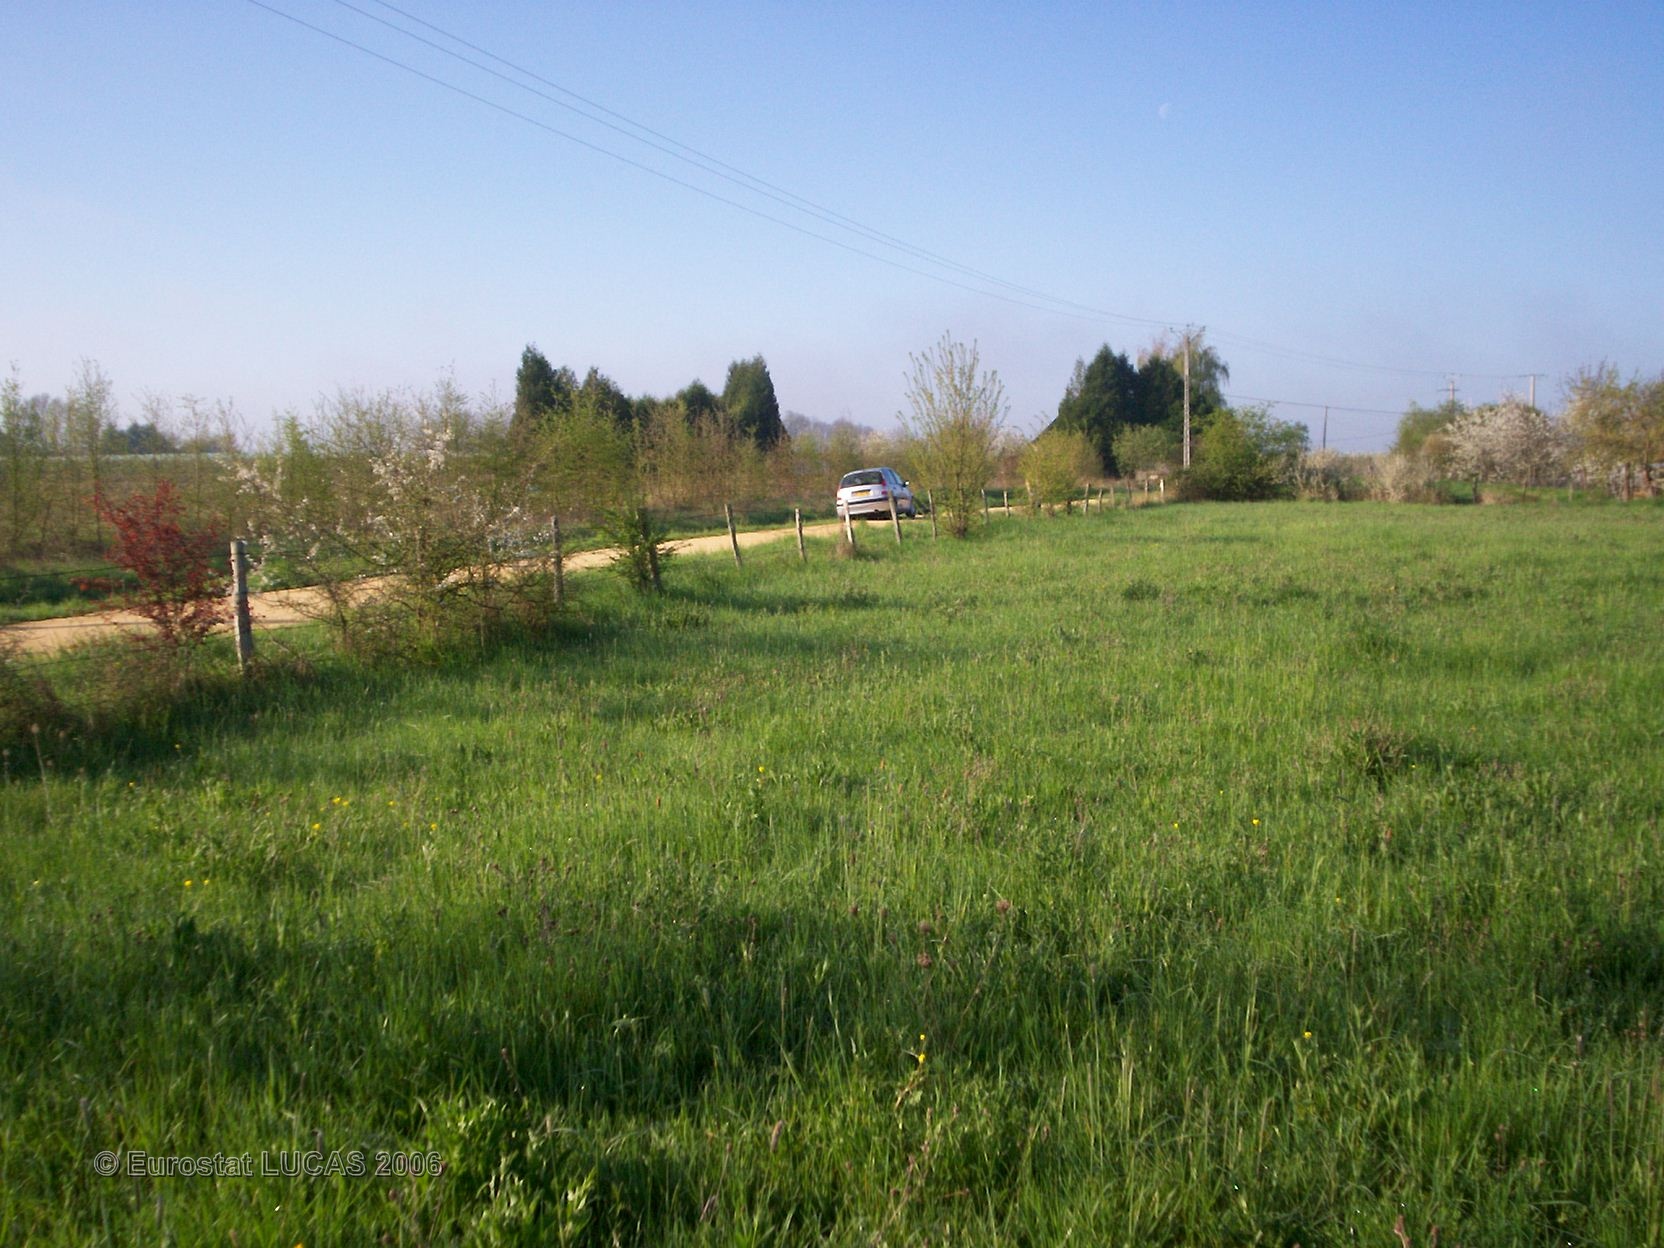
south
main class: Grassland
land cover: Grassland without tree/shrub cover
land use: Agriculture (excluding fallow land and kitchen gardens)
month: April
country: FR
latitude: 47.4922
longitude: -0.4231
